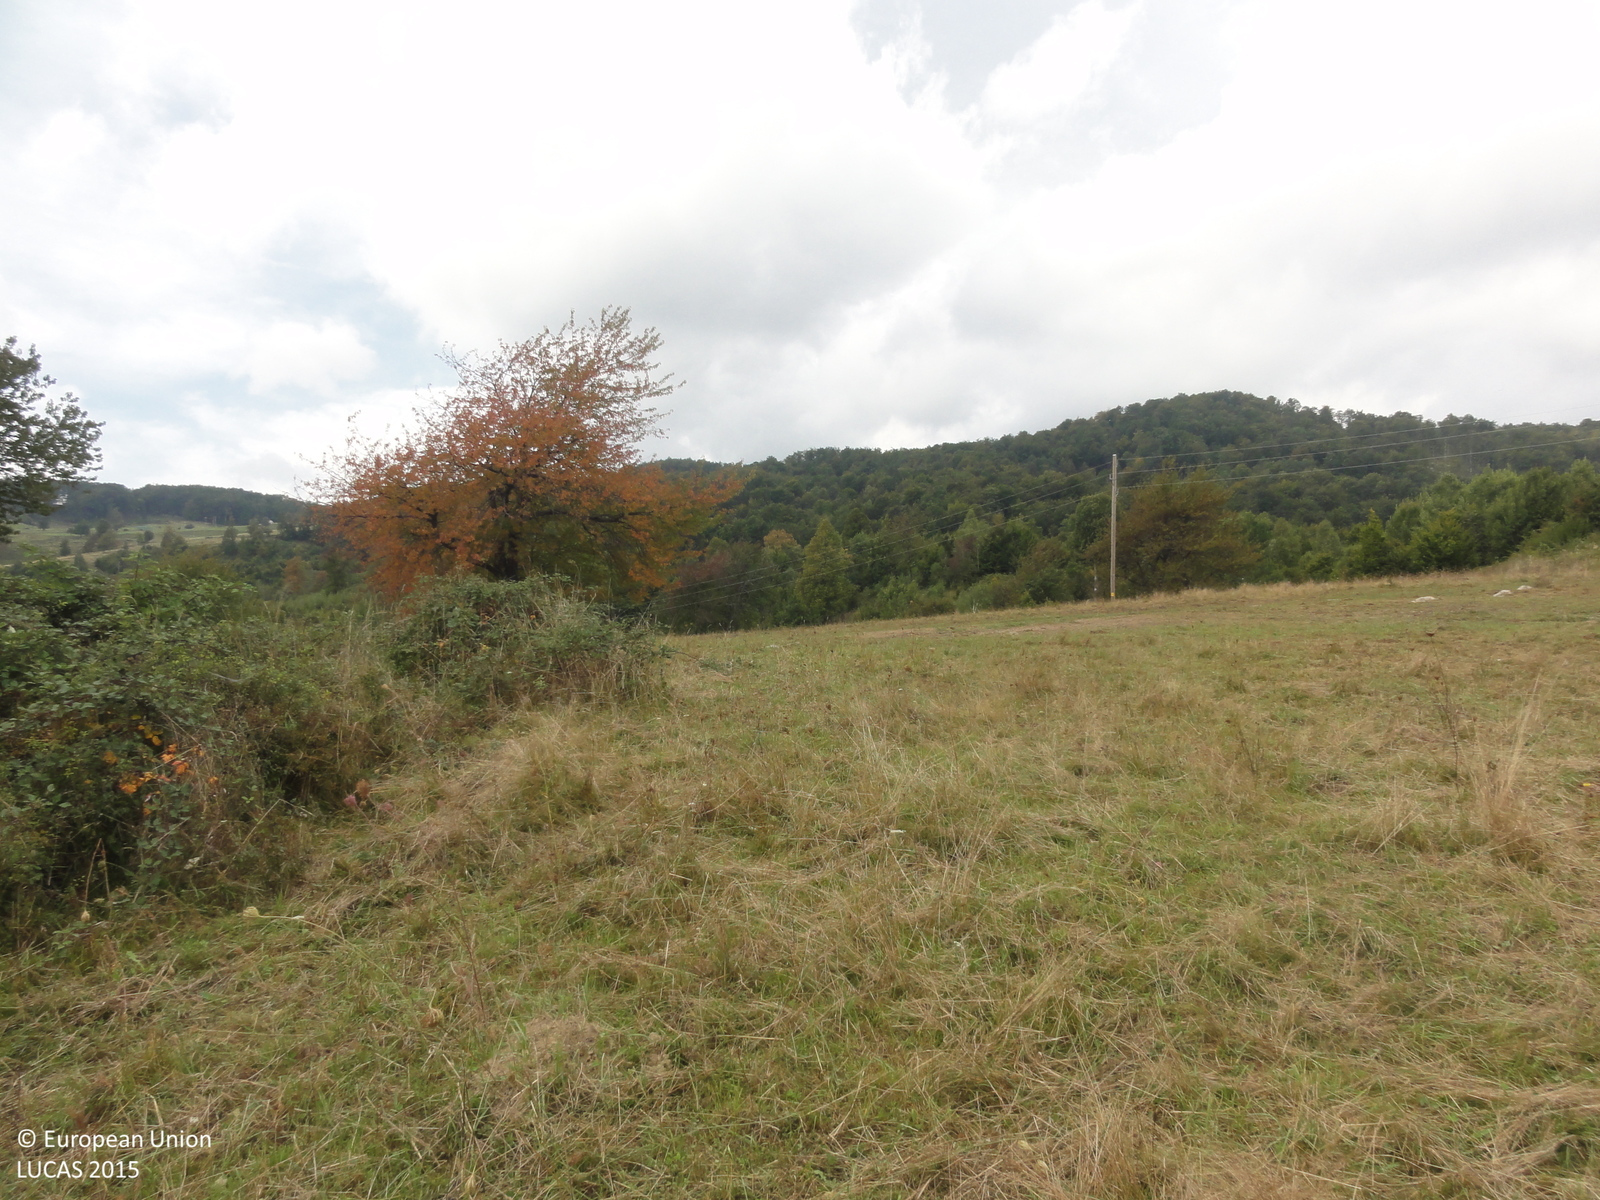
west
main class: Grassland
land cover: Grassland with sparse tree/shrub cover
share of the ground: > 75 %
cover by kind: herbaceous plants 90 %, broadleaved forest trees 5 %, shrubs 5 %
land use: Agriculture (excluding fallow land and kitchen gardens)
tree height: > 5 m
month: September
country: SI
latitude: 45.5830
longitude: 15.0328
